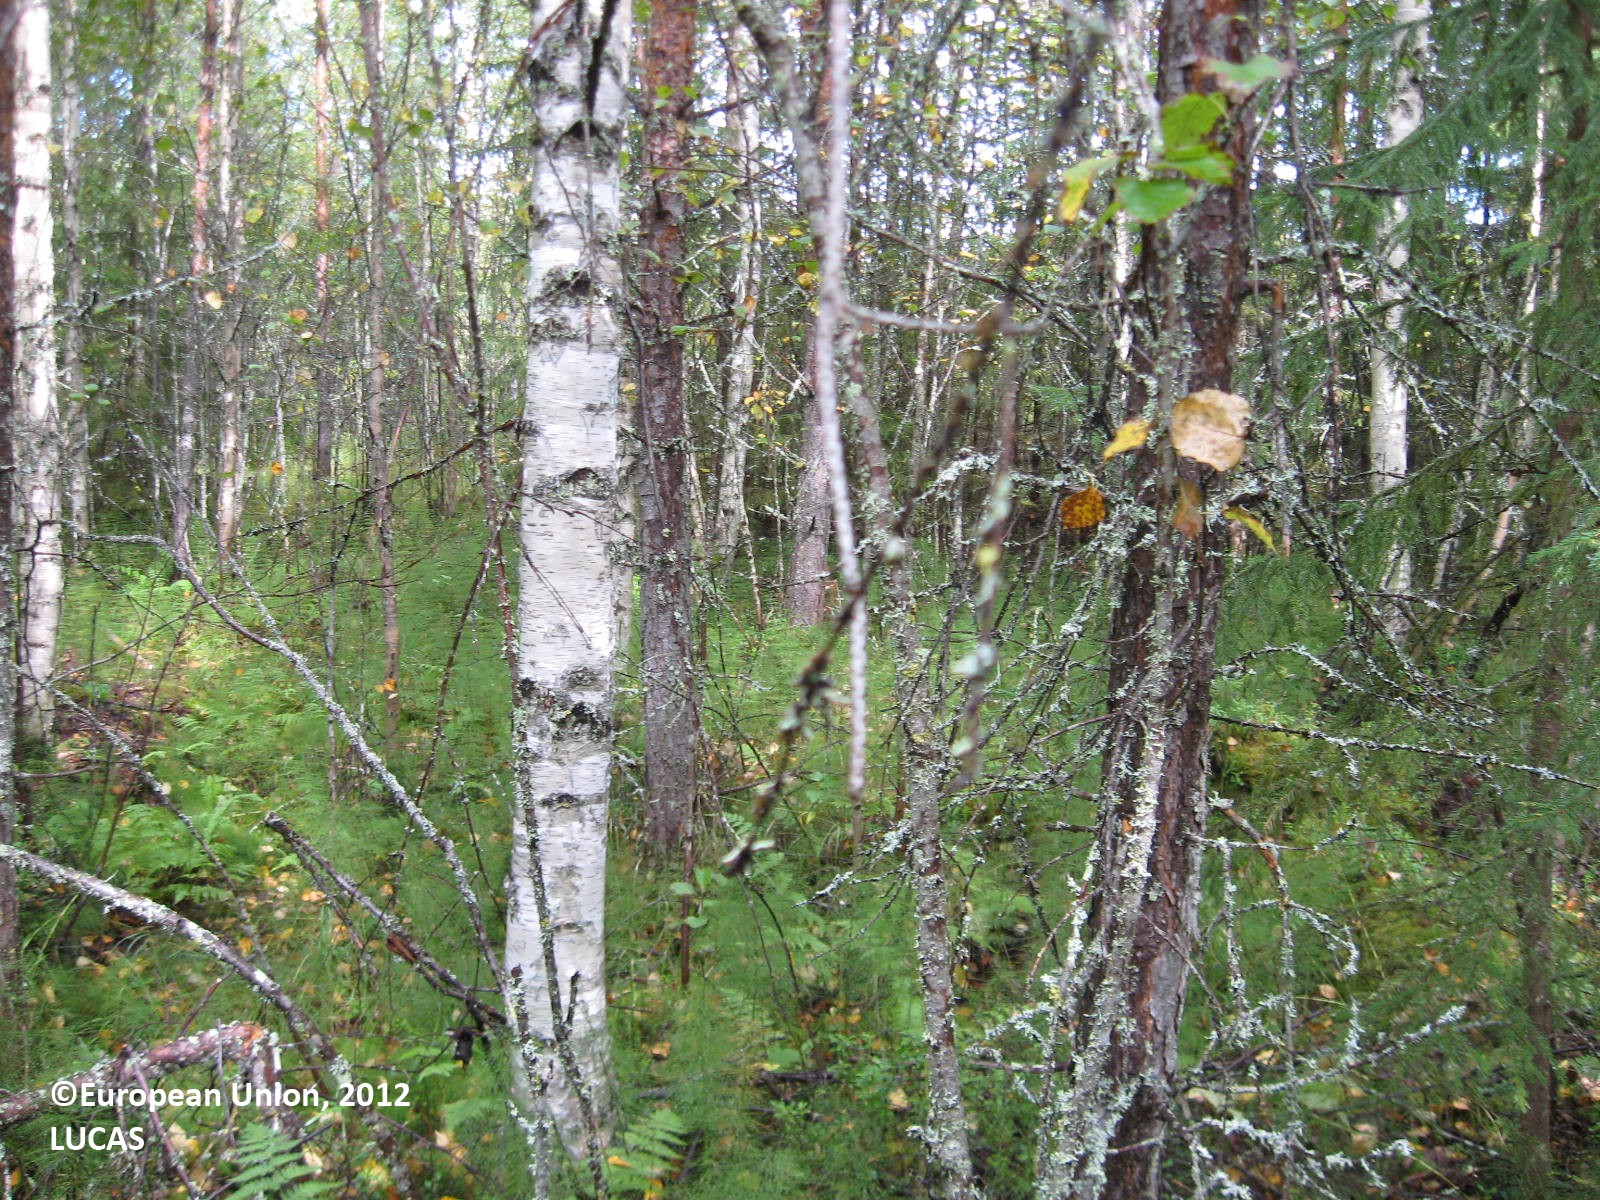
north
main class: Woodland
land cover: Other mixed woodland
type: boreal forest
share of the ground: > 75 %
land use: Forestry
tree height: > 5 m
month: August
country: FI
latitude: 63.4655
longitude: 29.8021
